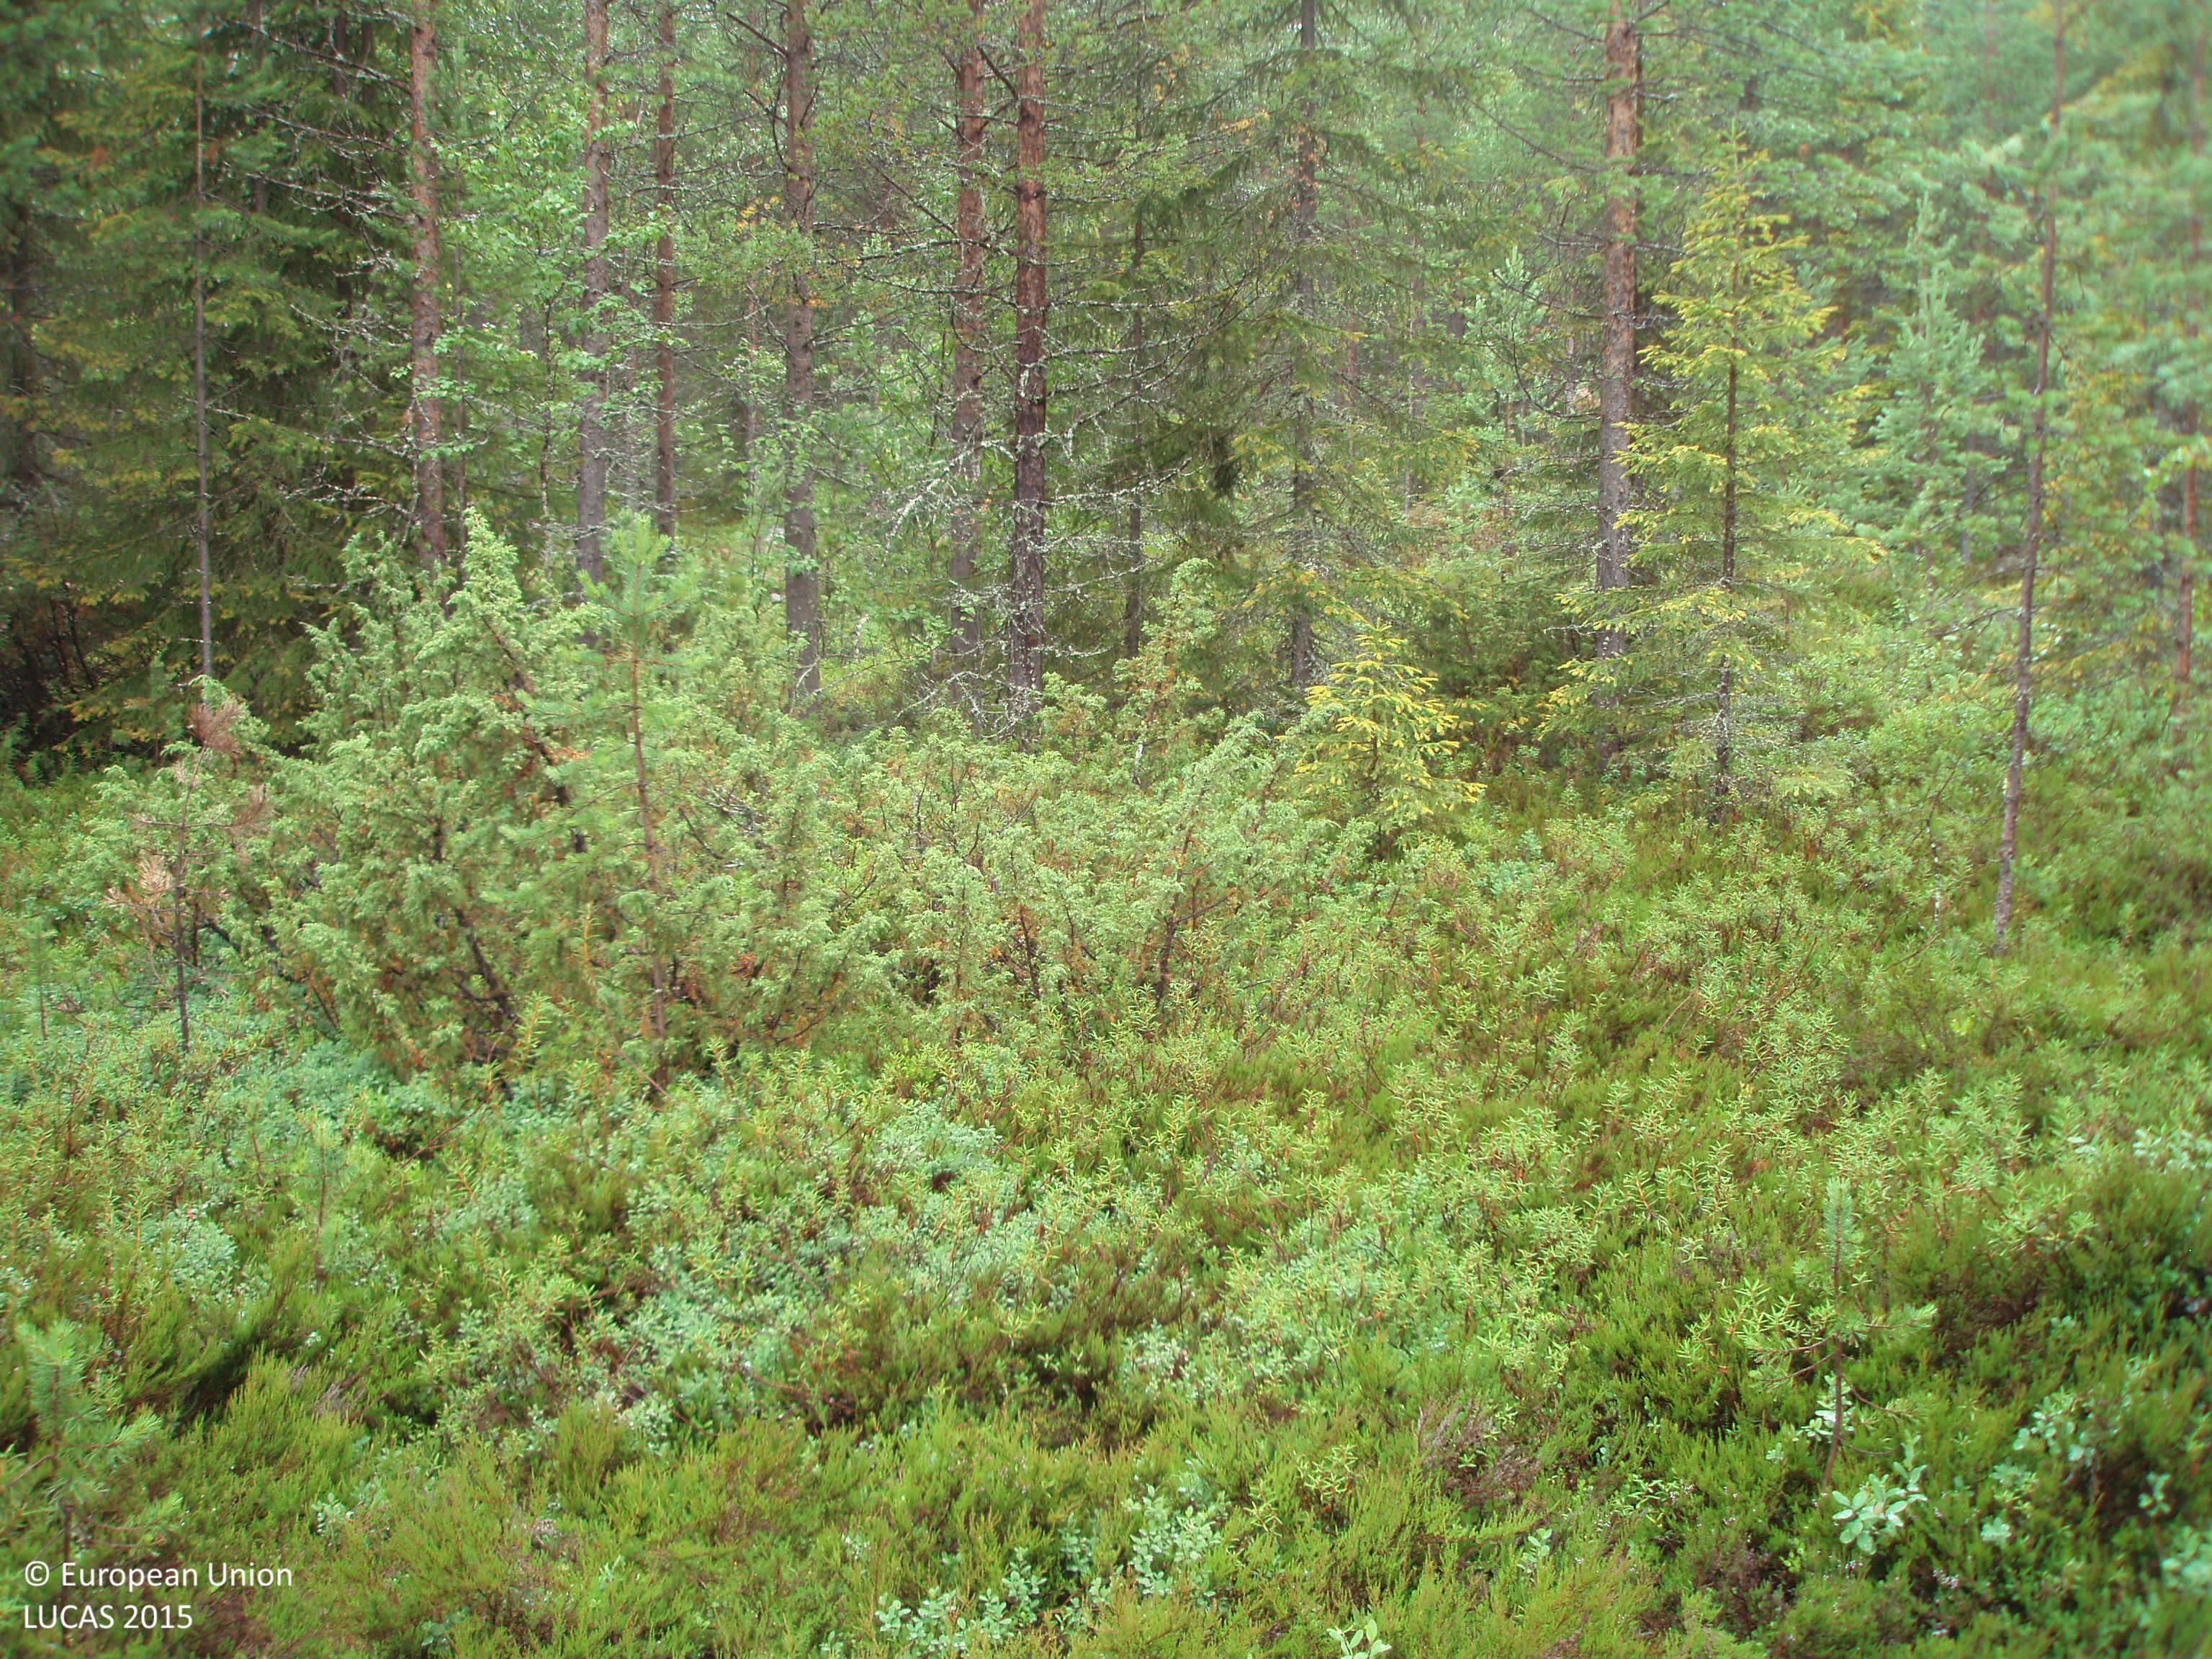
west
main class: Woodland
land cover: Pine dominated coniferous woodland
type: boreal forest
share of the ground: 25 - 50 %
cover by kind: shrubs 60 %, coniferous forest trees 40 %
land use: Forestry
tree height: > 5 m
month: August
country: FI
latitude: 65.5795
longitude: 27.4466
